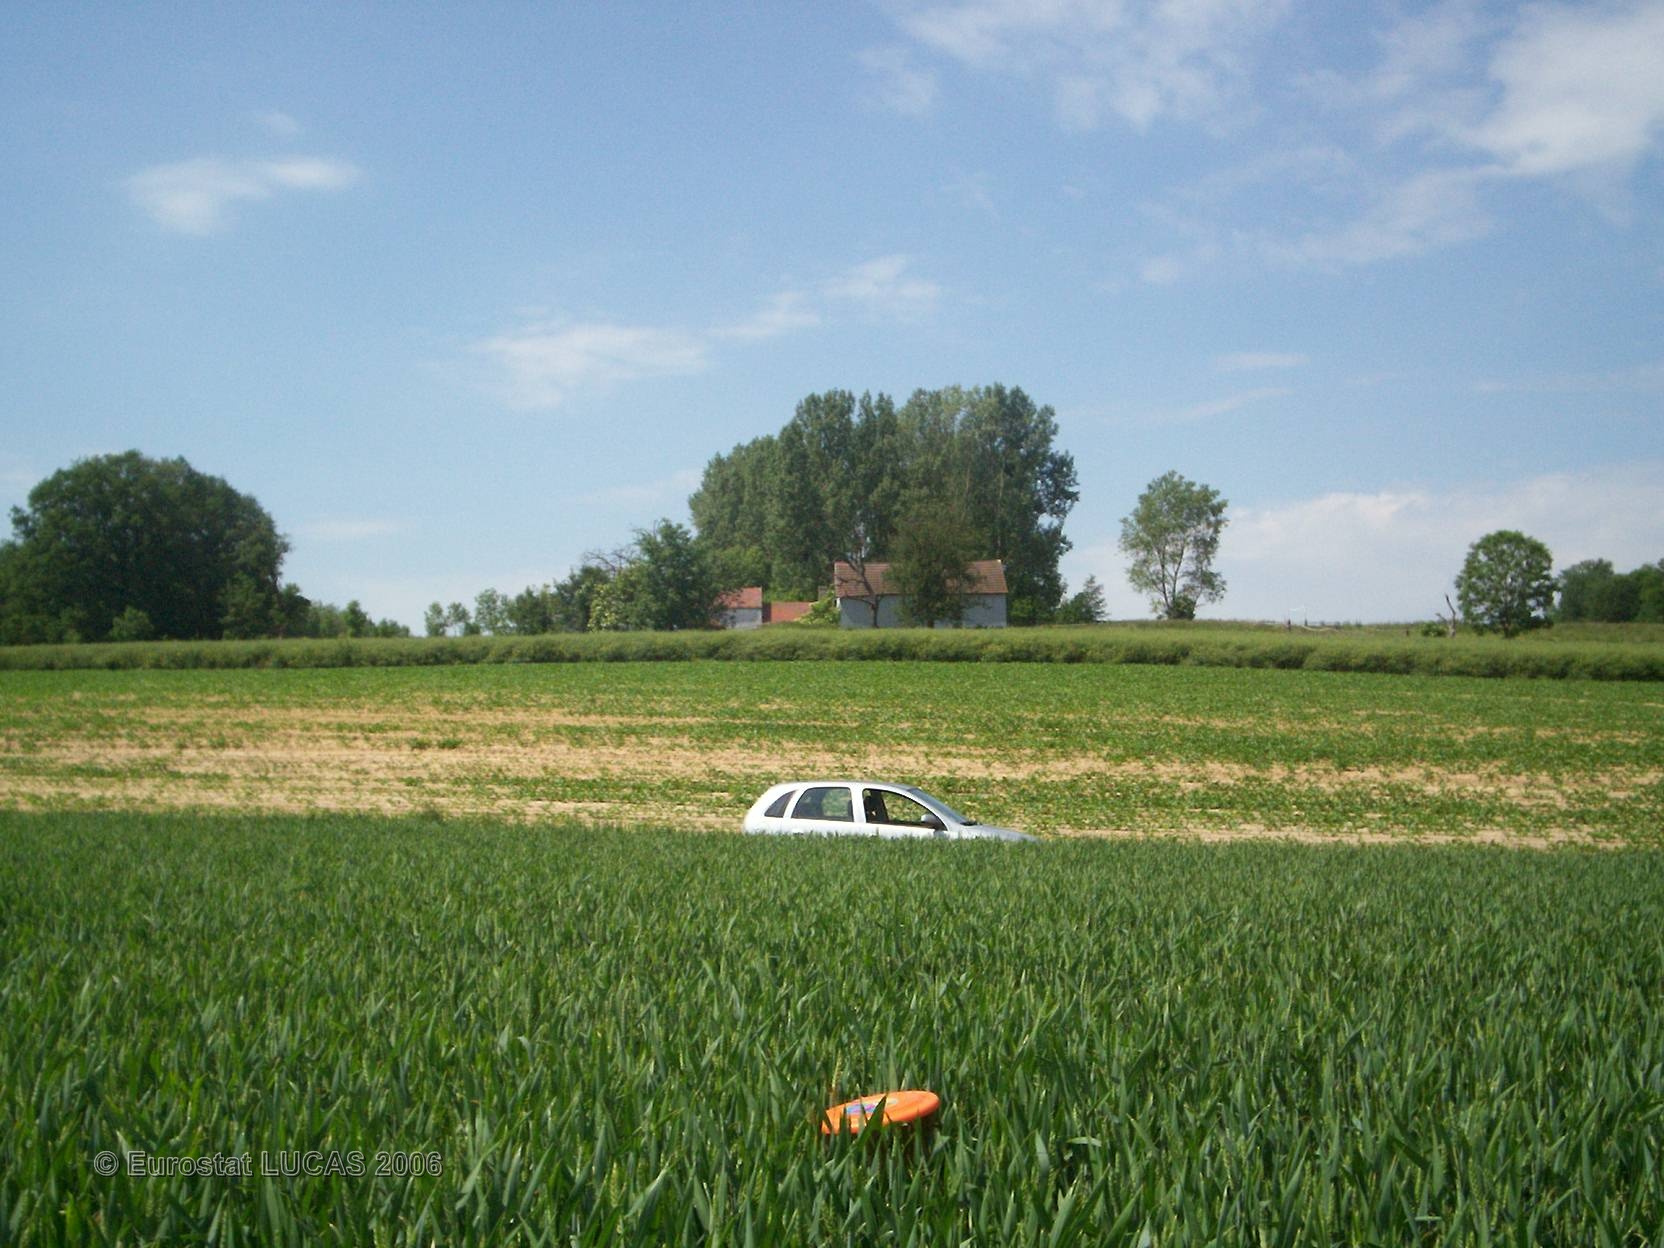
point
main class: Cropland
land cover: Common wheat
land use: Agriculture (excluding fallow land and kitchen gardens)
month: June
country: FR
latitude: 49.4100
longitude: 2.7258
